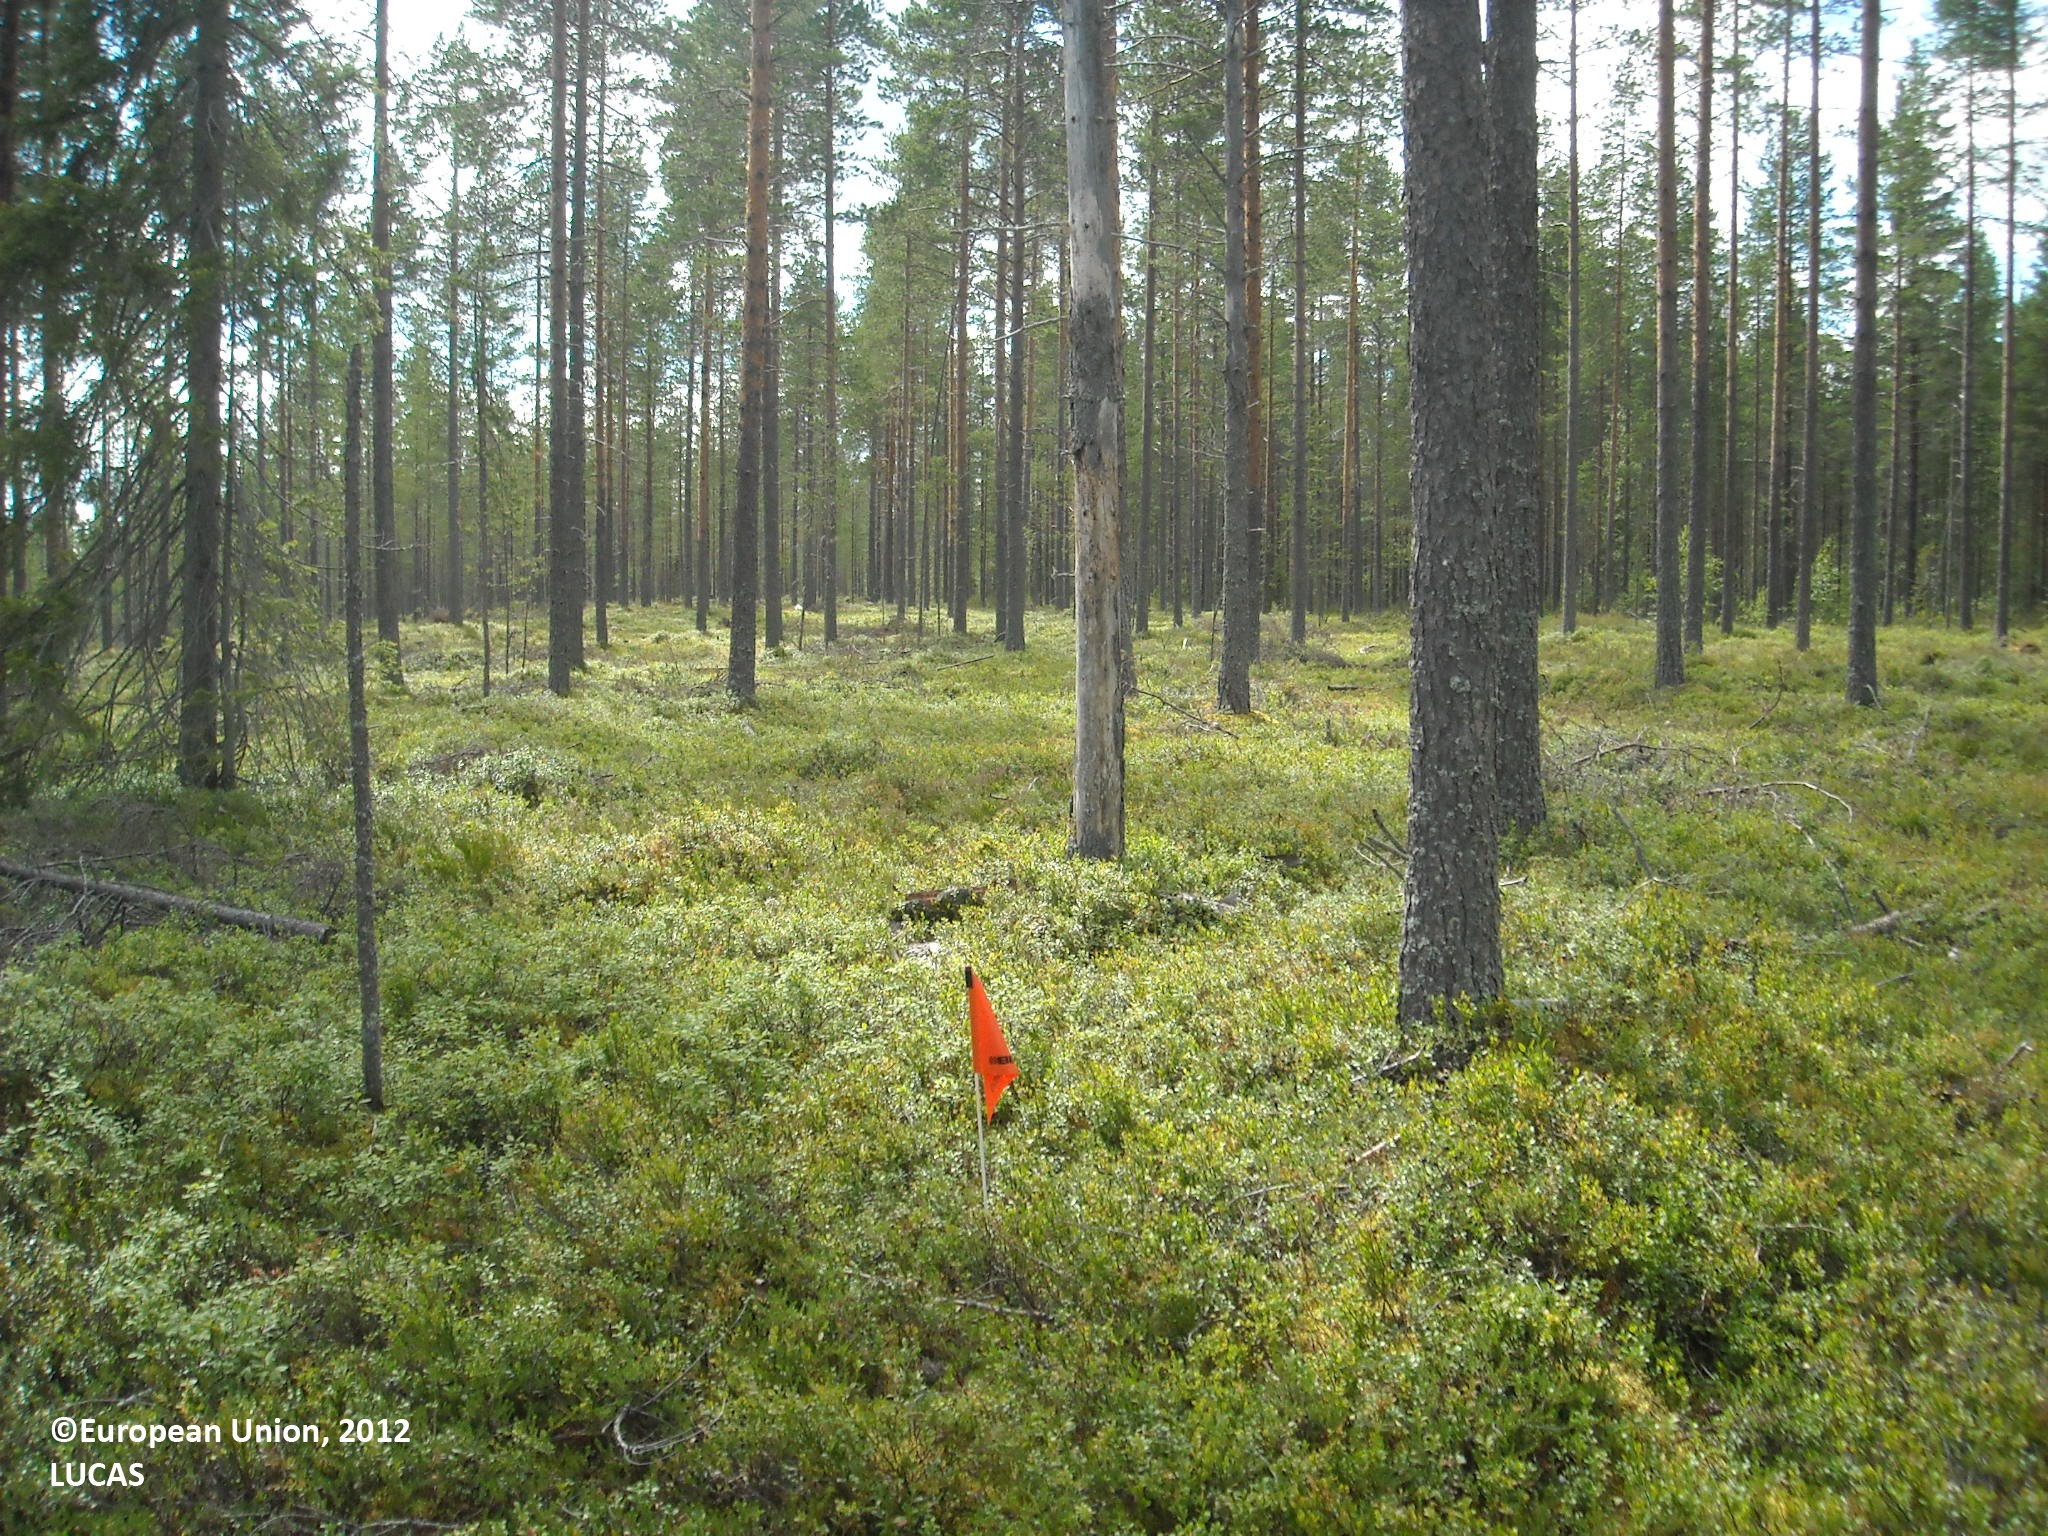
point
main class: Woodland
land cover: Pine dominated coniferous woodland
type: boreal forest
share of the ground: 25 - 50 %
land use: Forestry
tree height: > 5 m
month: July
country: FI
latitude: 64.9789
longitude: 26.9671
